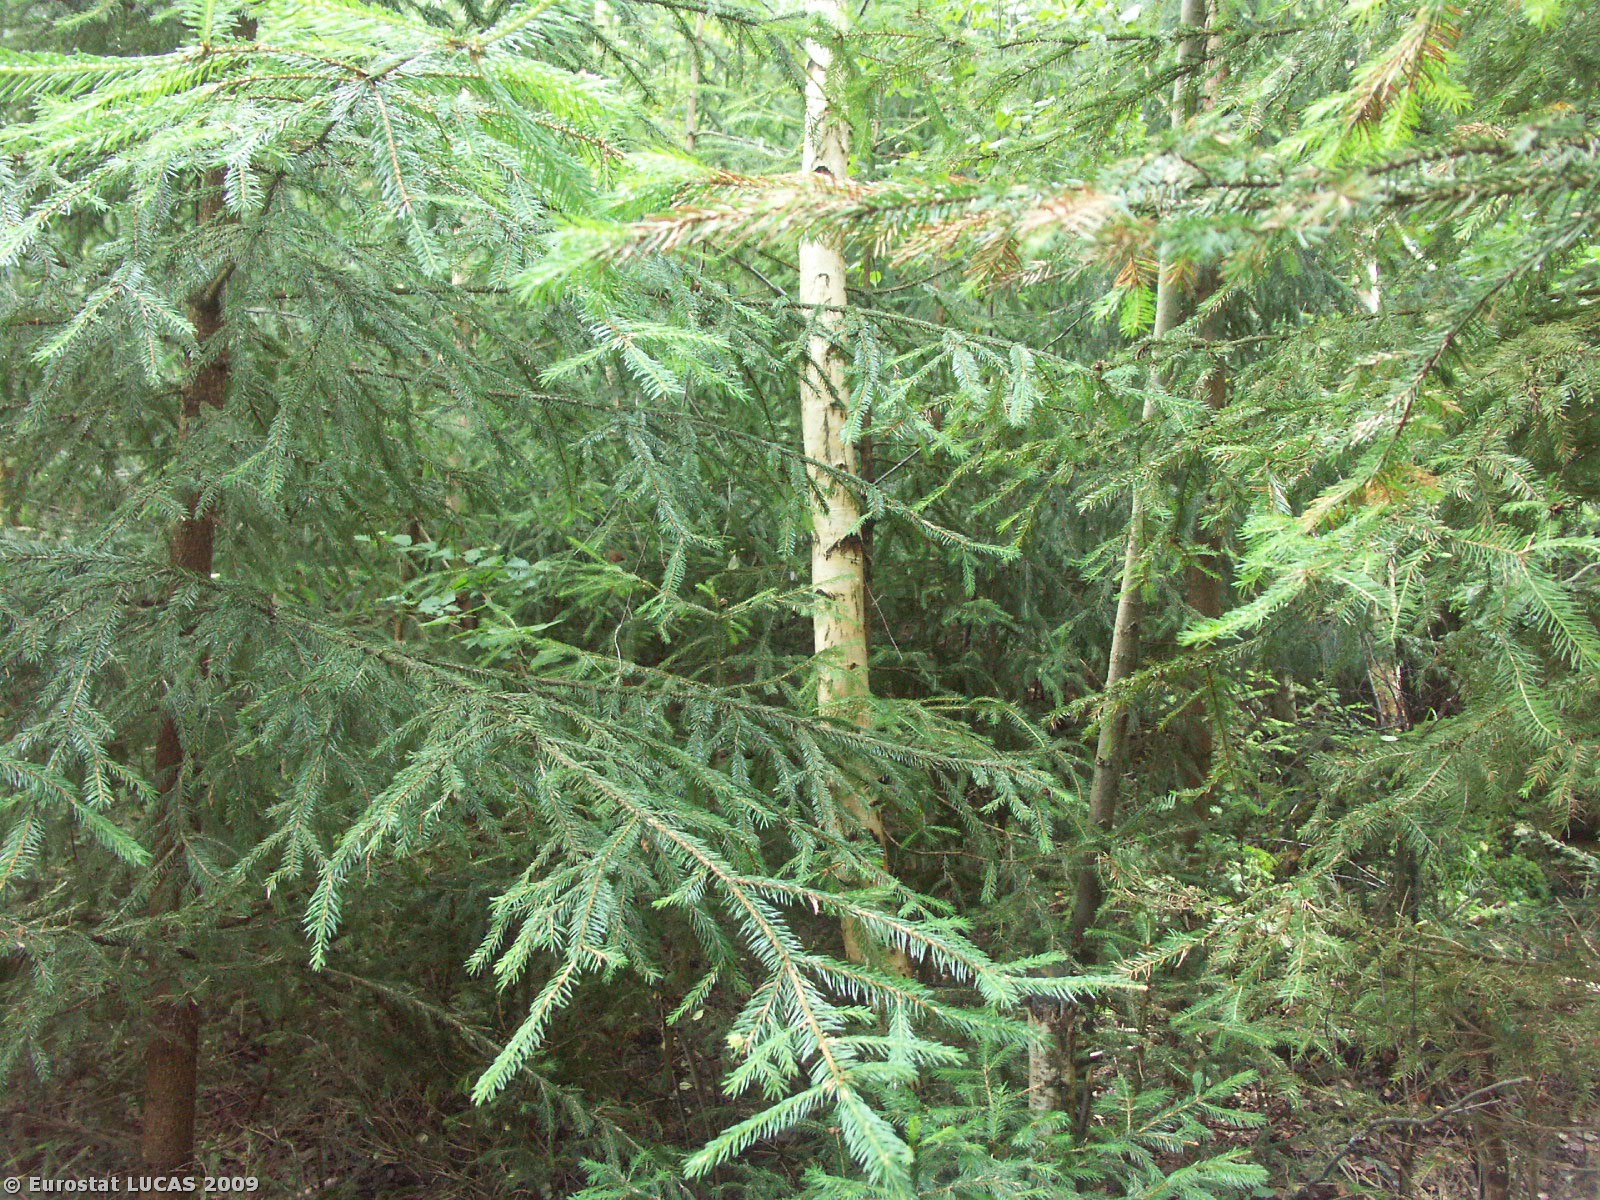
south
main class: Woodland
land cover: Mixed woodland
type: hemiboreal forest and nemoral coniferous forest and mixed broadleaved-coniferous forest
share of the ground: > 75 %
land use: Forestry
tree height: > 5 m
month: July
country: CZ
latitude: 49.8893
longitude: 17.4028
